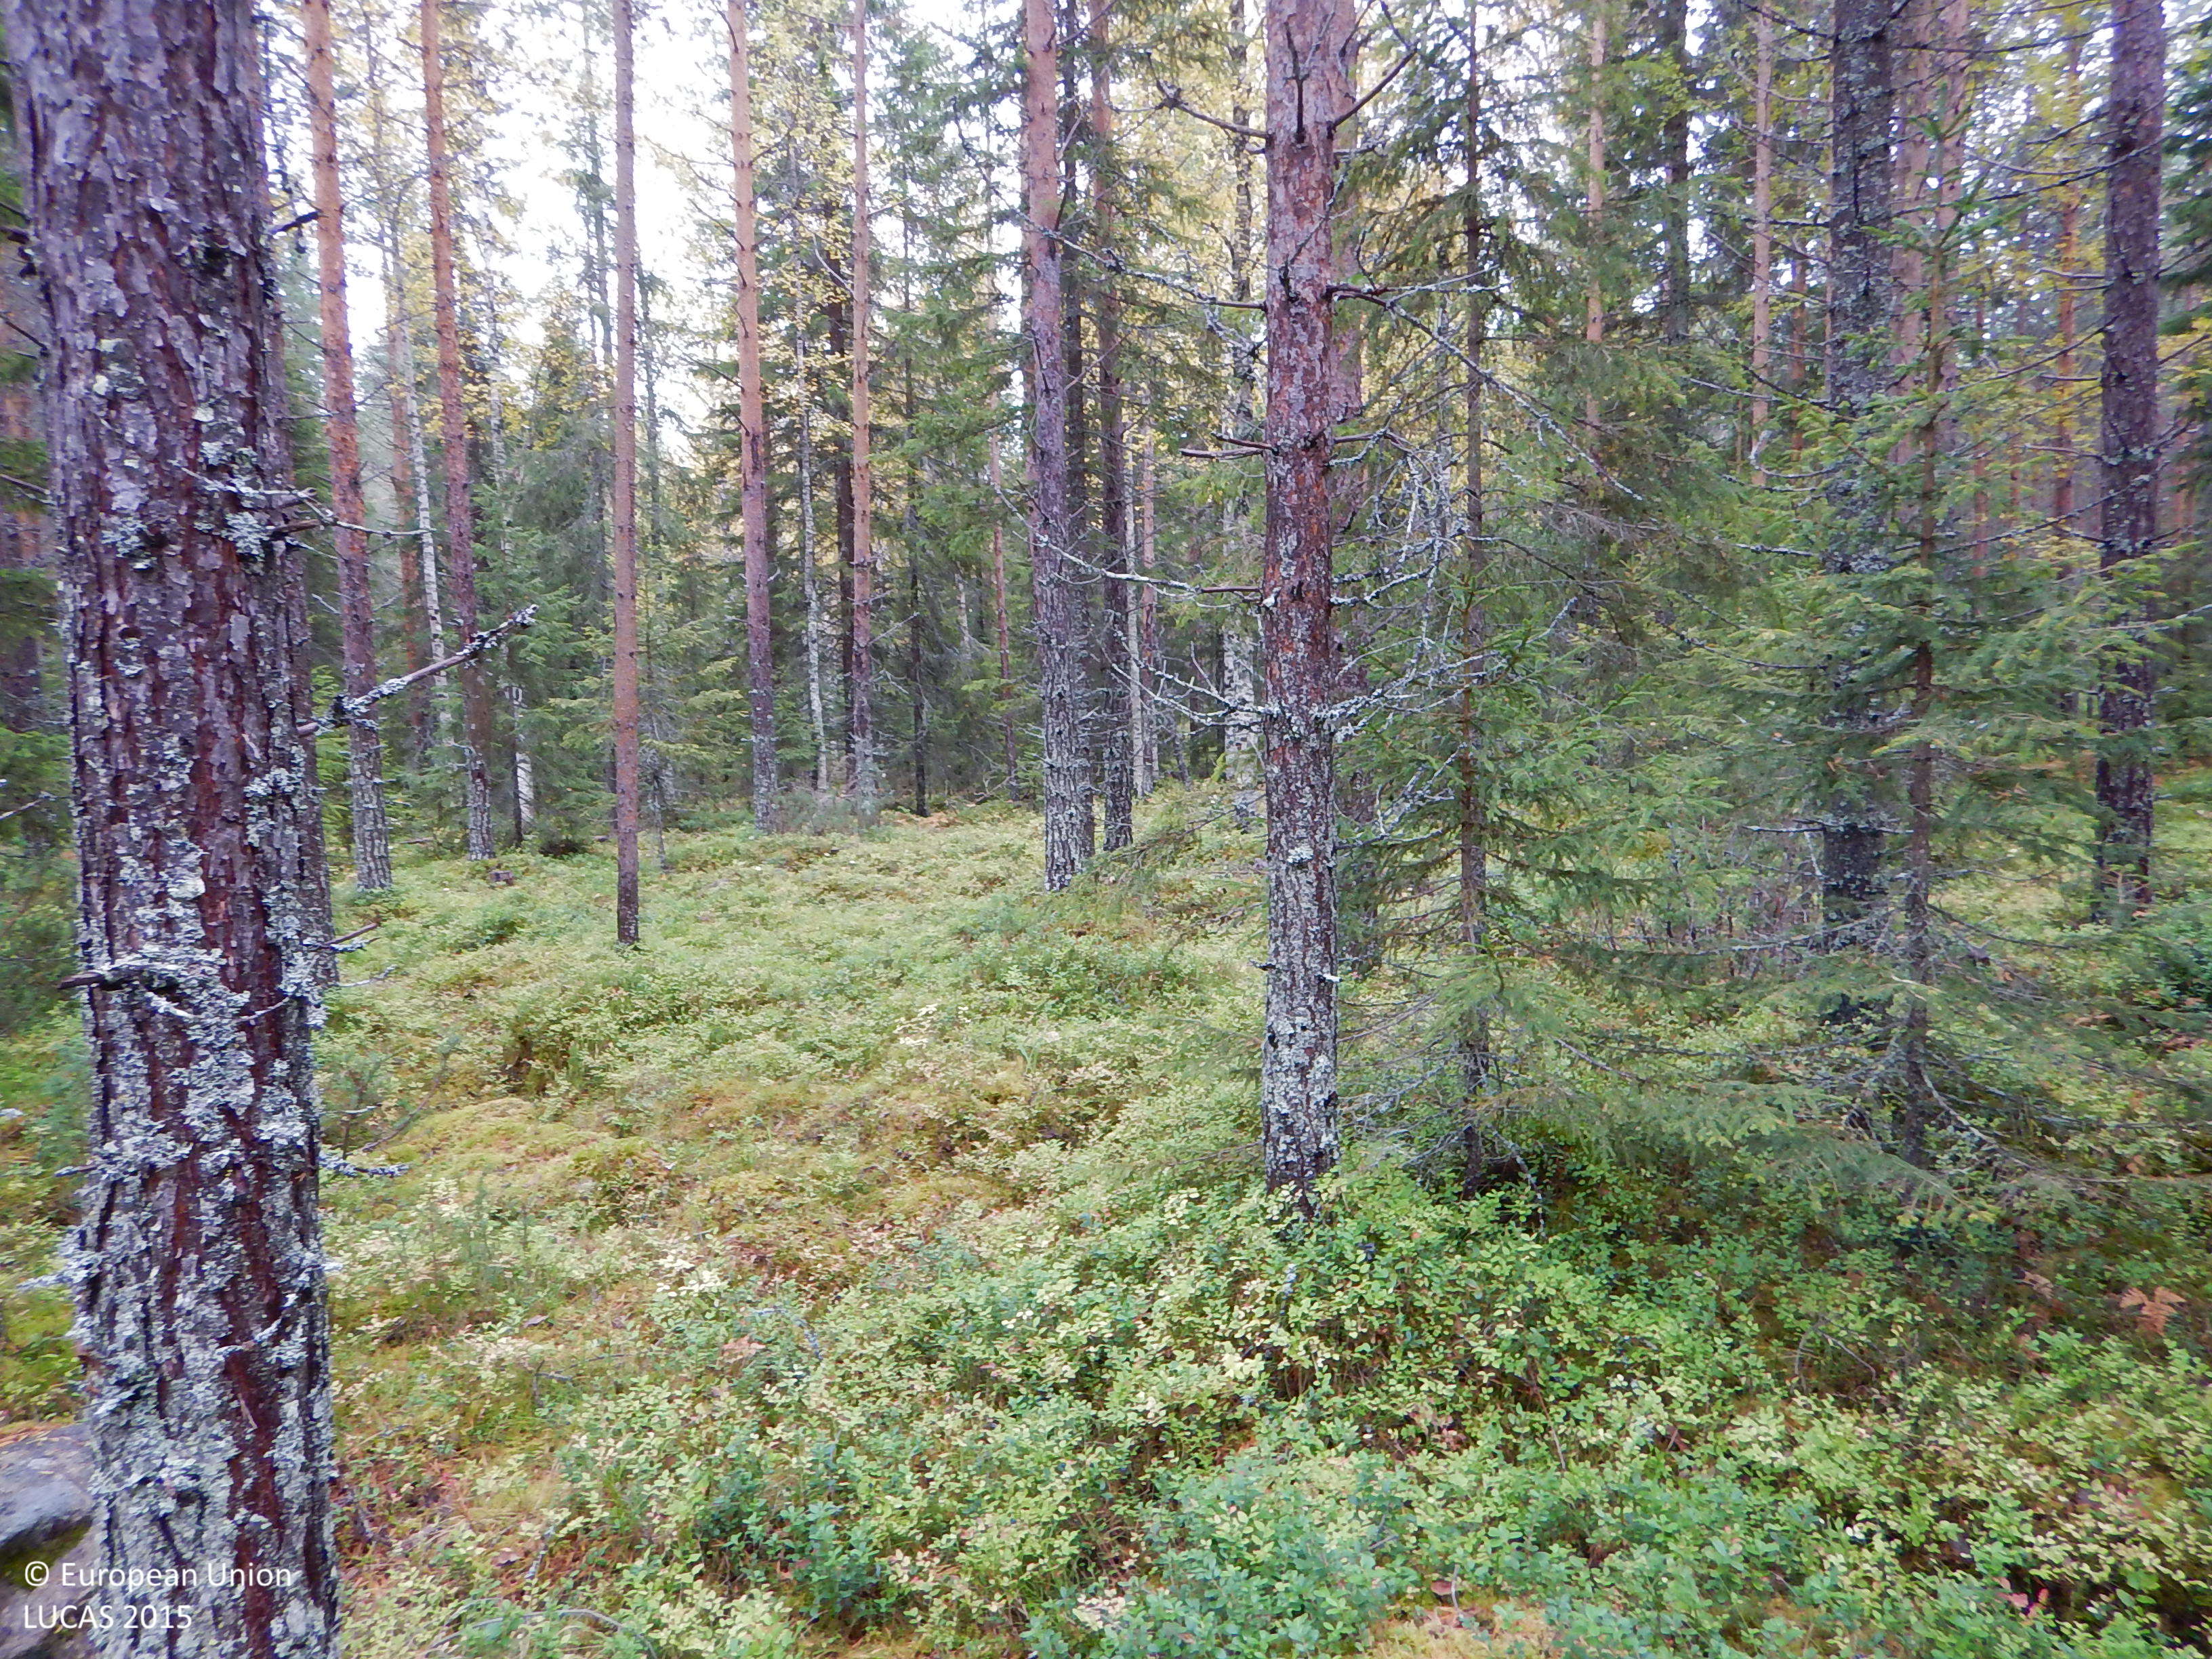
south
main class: Woodland
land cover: Pine dominated coniferous woodland
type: boreal forest
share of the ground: 50 - 75 %
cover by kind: coniferous forest trees 60 %, shrubs 20 %, lichens and mosses 20 %
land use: Forestry
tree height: > 5 m
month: September
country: SE
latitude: 65.1326
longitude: 19.1930
